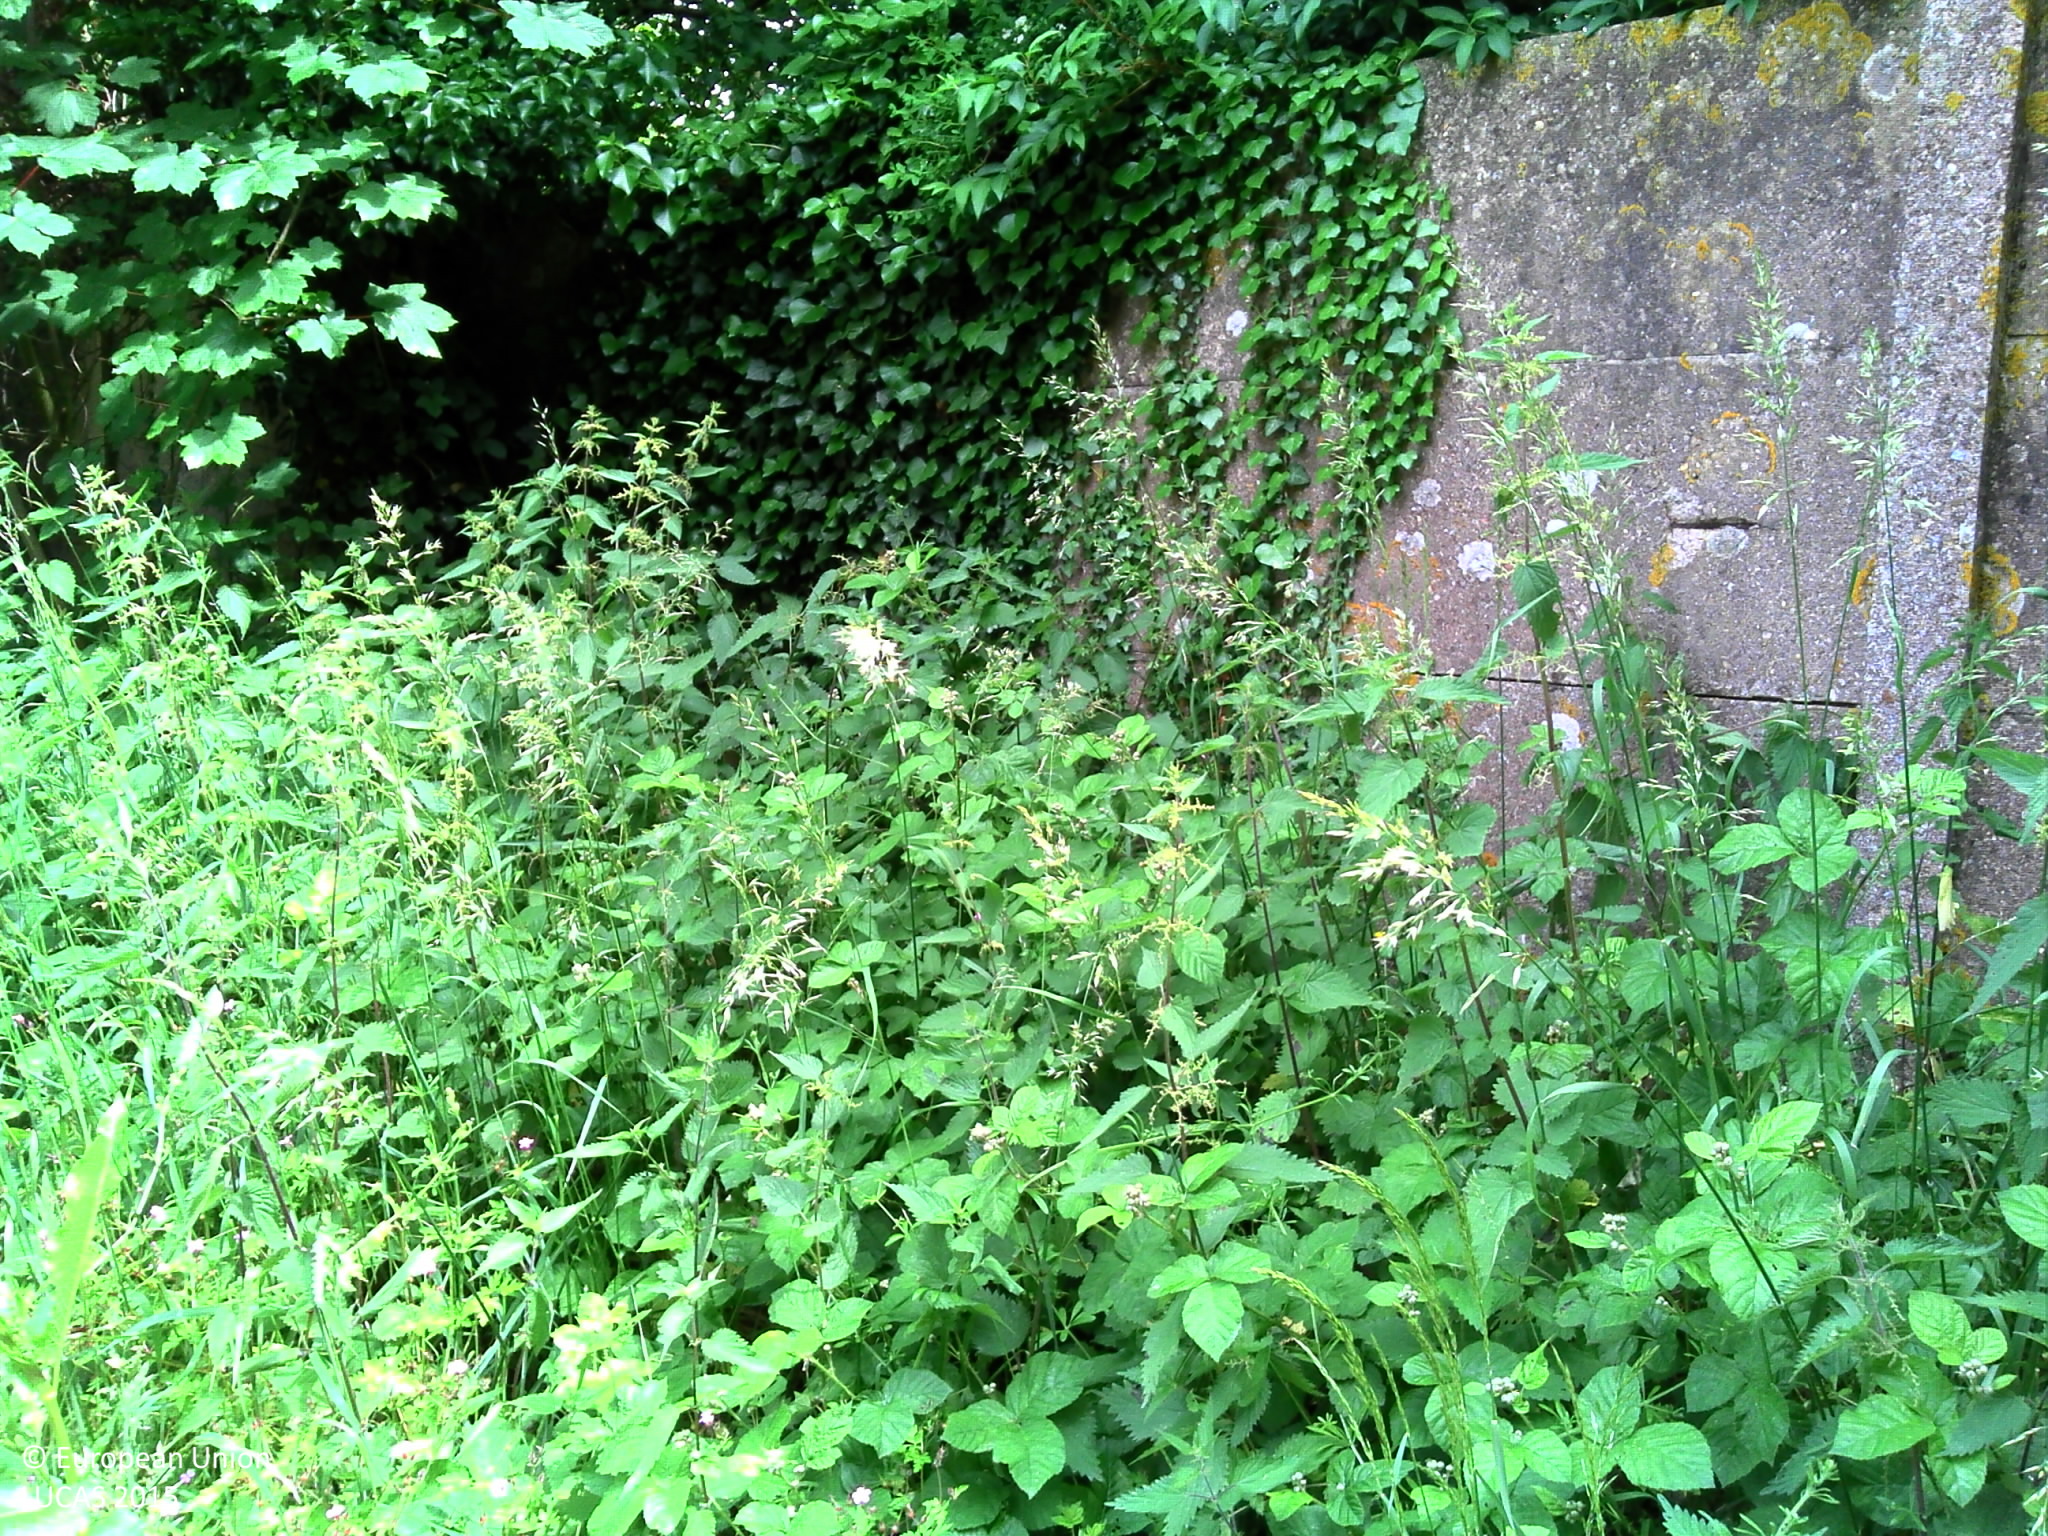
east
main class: Grassland
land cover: Grassland without tree/shrub cover
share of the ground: > 75 %
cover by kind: herbaceous plants 80 %
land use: Semi-natural and natural areas not in use
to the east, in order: Grassland without tree/shrub cover; Artificial constructions in urban areas; Broadleaved woodland; Spontaneously vegetated surfaces
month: June
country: FR
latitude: 50.5112
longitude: 2.4426
